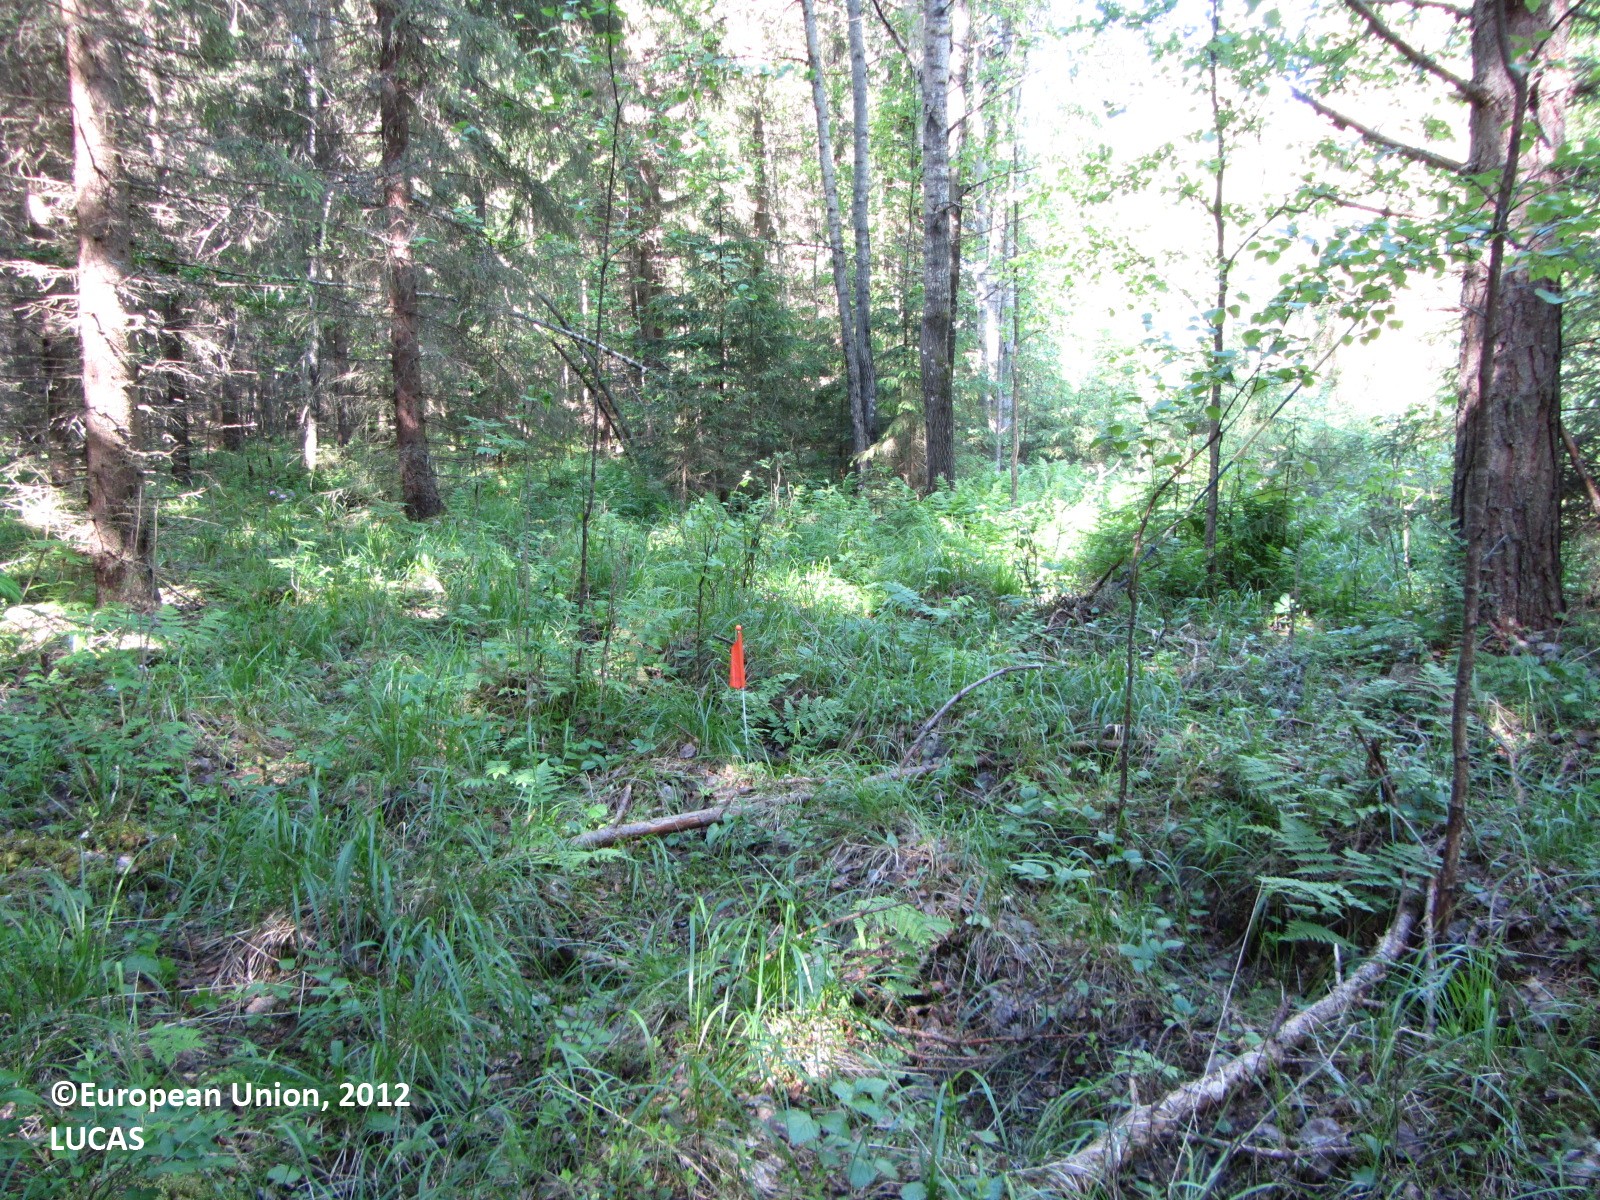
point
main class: Woodland
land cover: Spruce dominated mixed woodland
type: boreal forest
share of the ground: 50 - 75 %
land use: Forestry
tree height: > 5 m
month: June
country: FI
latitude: 62.0174
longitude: 25.7306
